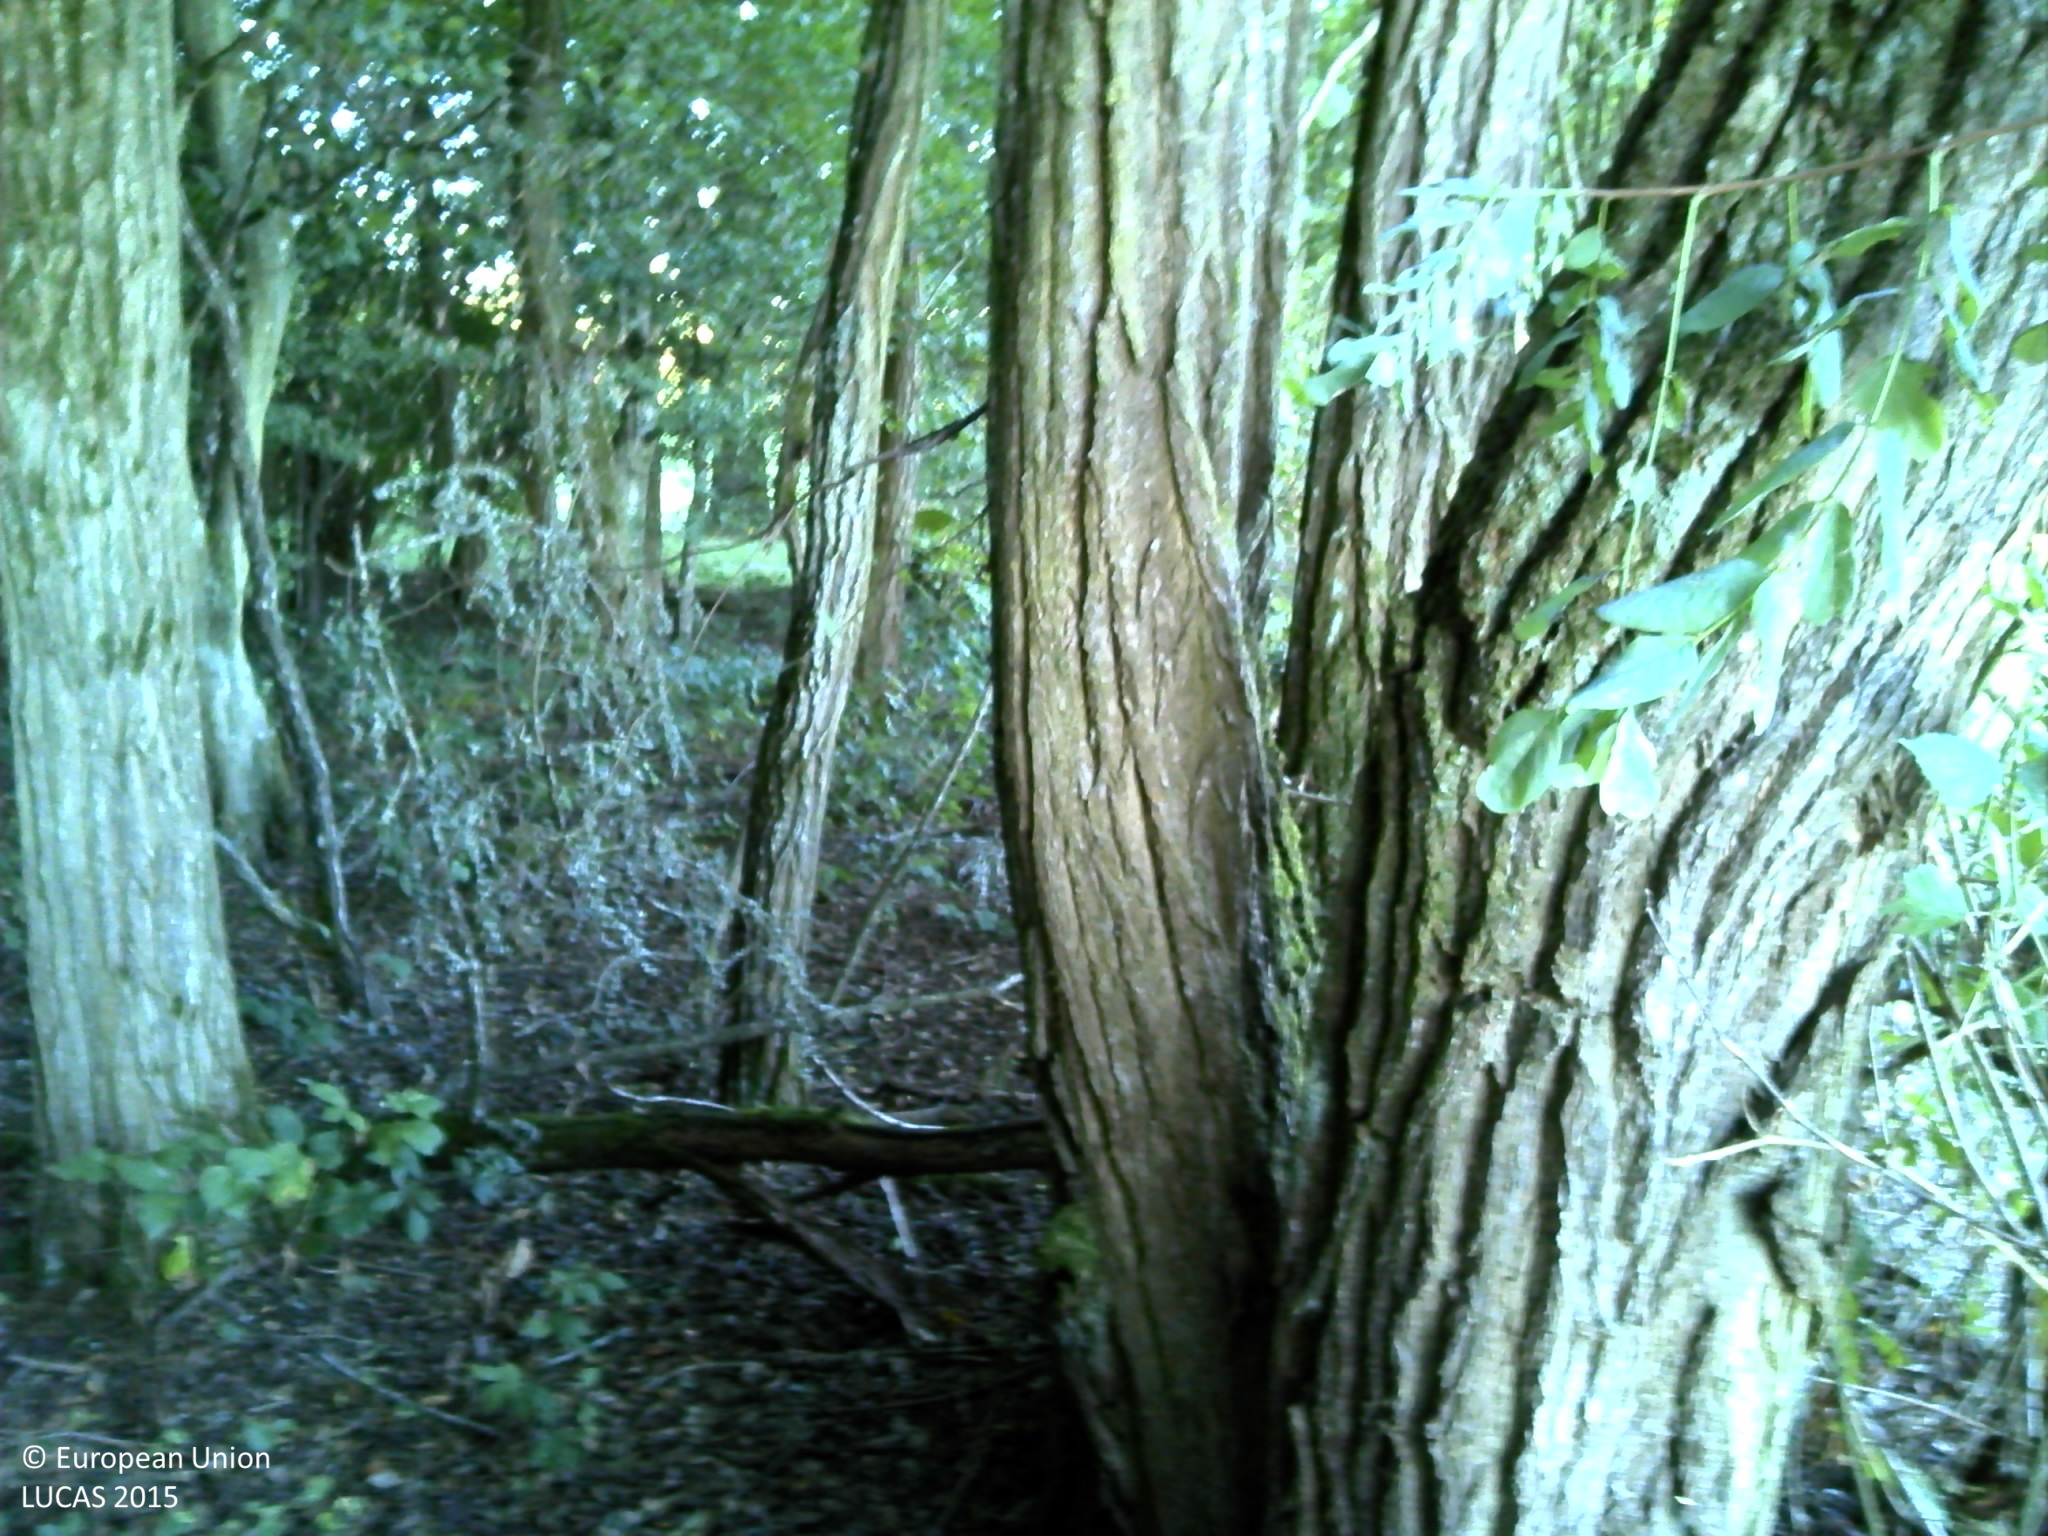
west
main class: Grassland
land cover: Grassland without tree/shrub cover
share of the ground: > 75 %
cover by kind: herbaceous plants 100 %
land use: Agriculture (excluding fallow land and kitchen gardens)
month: September
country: FR
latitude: 47.0006
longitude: 4.4370
